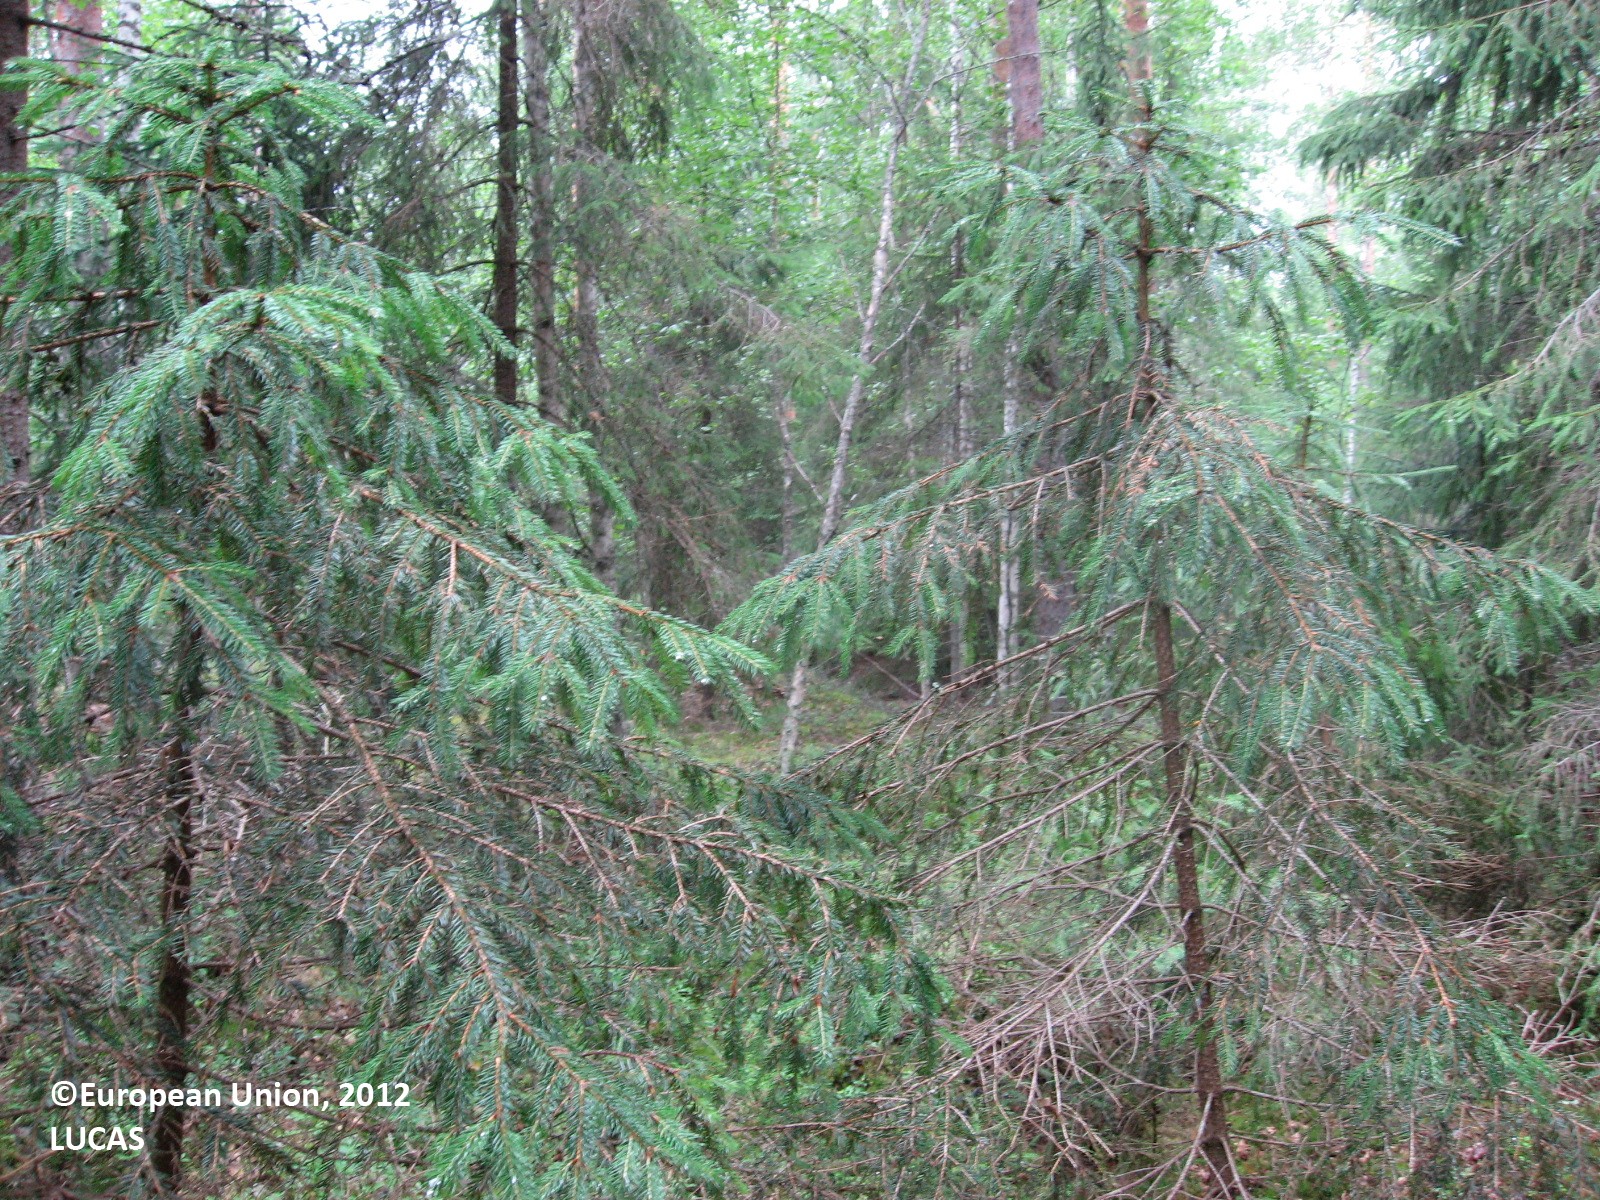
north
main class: Woodland
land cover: Spruce dominated mixed woodland
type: boreal forest
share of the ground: 50 - 75 %
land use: Forestry
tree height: > 5 m
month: July
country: FI
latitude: 61.3575
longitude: 25.8592
